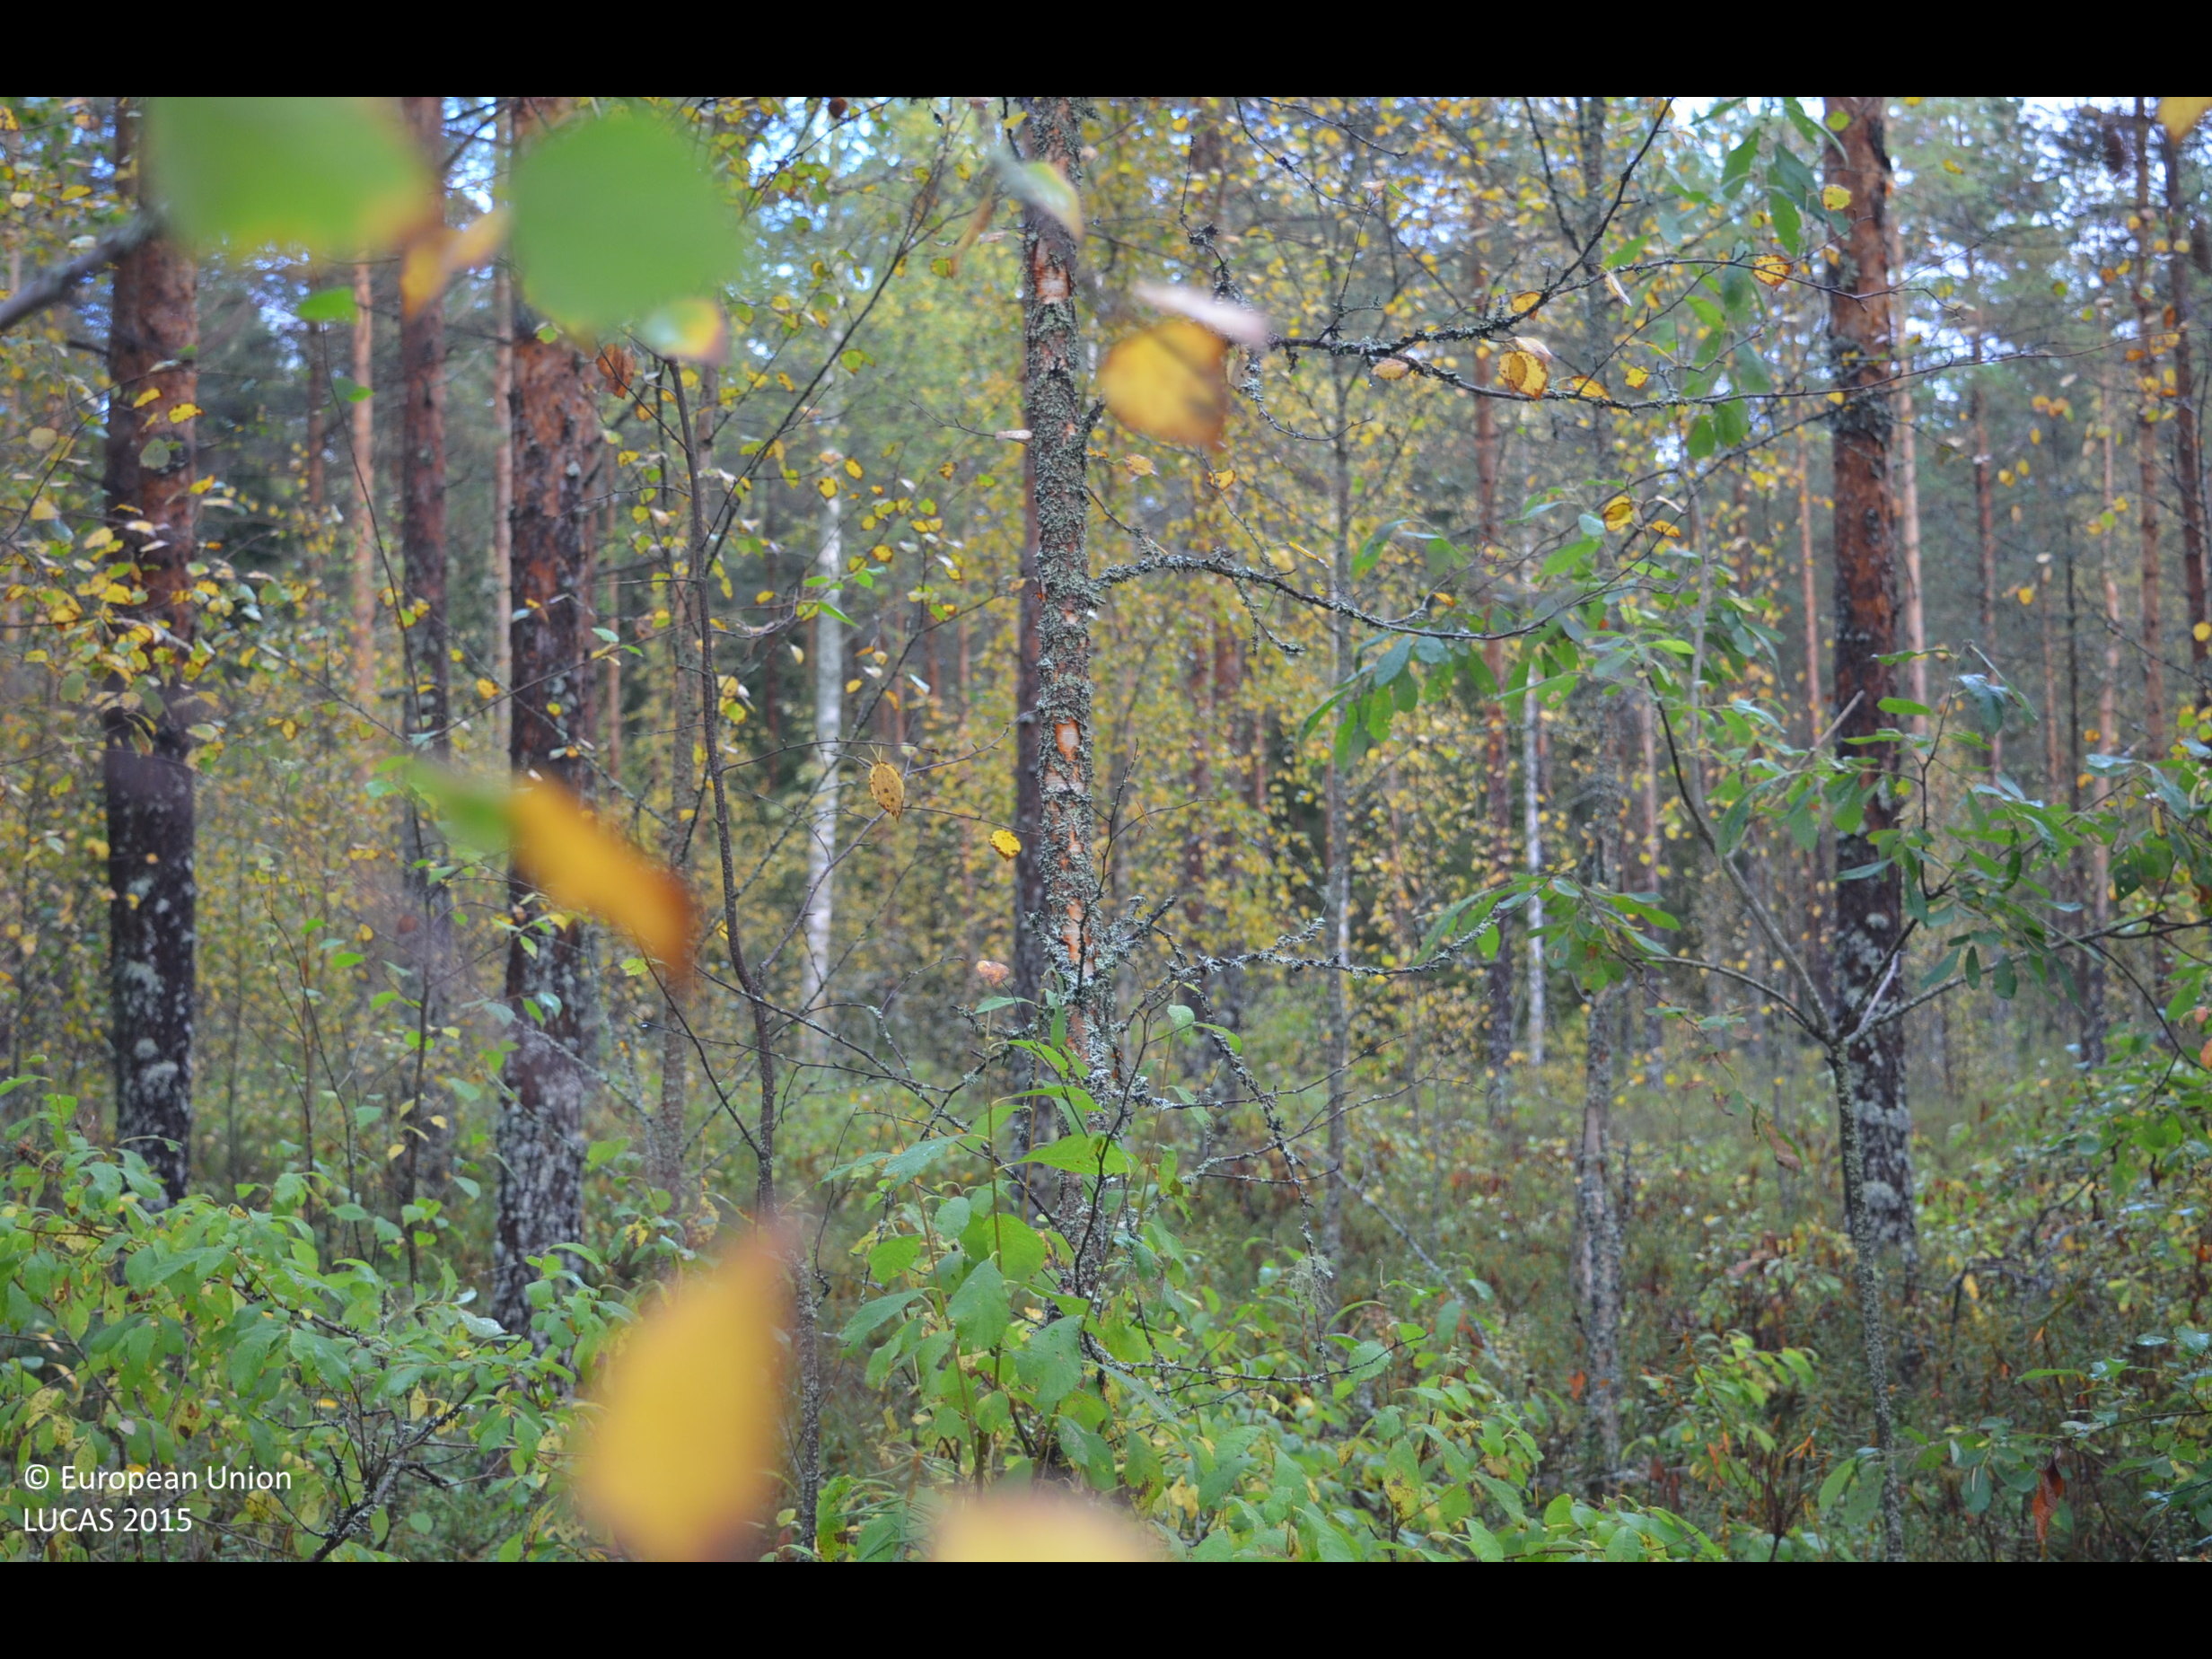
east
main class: Woodland
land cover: Pine dominated mixed woodland
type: boreal forest
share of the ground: > 75 %
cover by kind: coniferous forest trees 55 %, shrubs 25 %, broadleaved forest trees 20 %
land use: Forestry
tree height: > 5 m
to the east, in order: Pine dominated mixed woodland; Ditches and canals; Pine dominated mixed woodland; Ditches and canals; Grassland without tree/shrub cover; Ditches and canals; Pine dominated mixed woodland; Ditches and canals; Other mixed woodland; Ditches and canals; Other mixed woodland; Ditches and canals; Pine dominated mixed woodland; Ditches and canals; Pine dominated mixed woodland; Ditches and canals; Pine dominated mixed woodland; Ditches and canals; Pine dominated mixed woodland
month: September
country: FI
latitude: 62.9135
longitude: 23.9536
